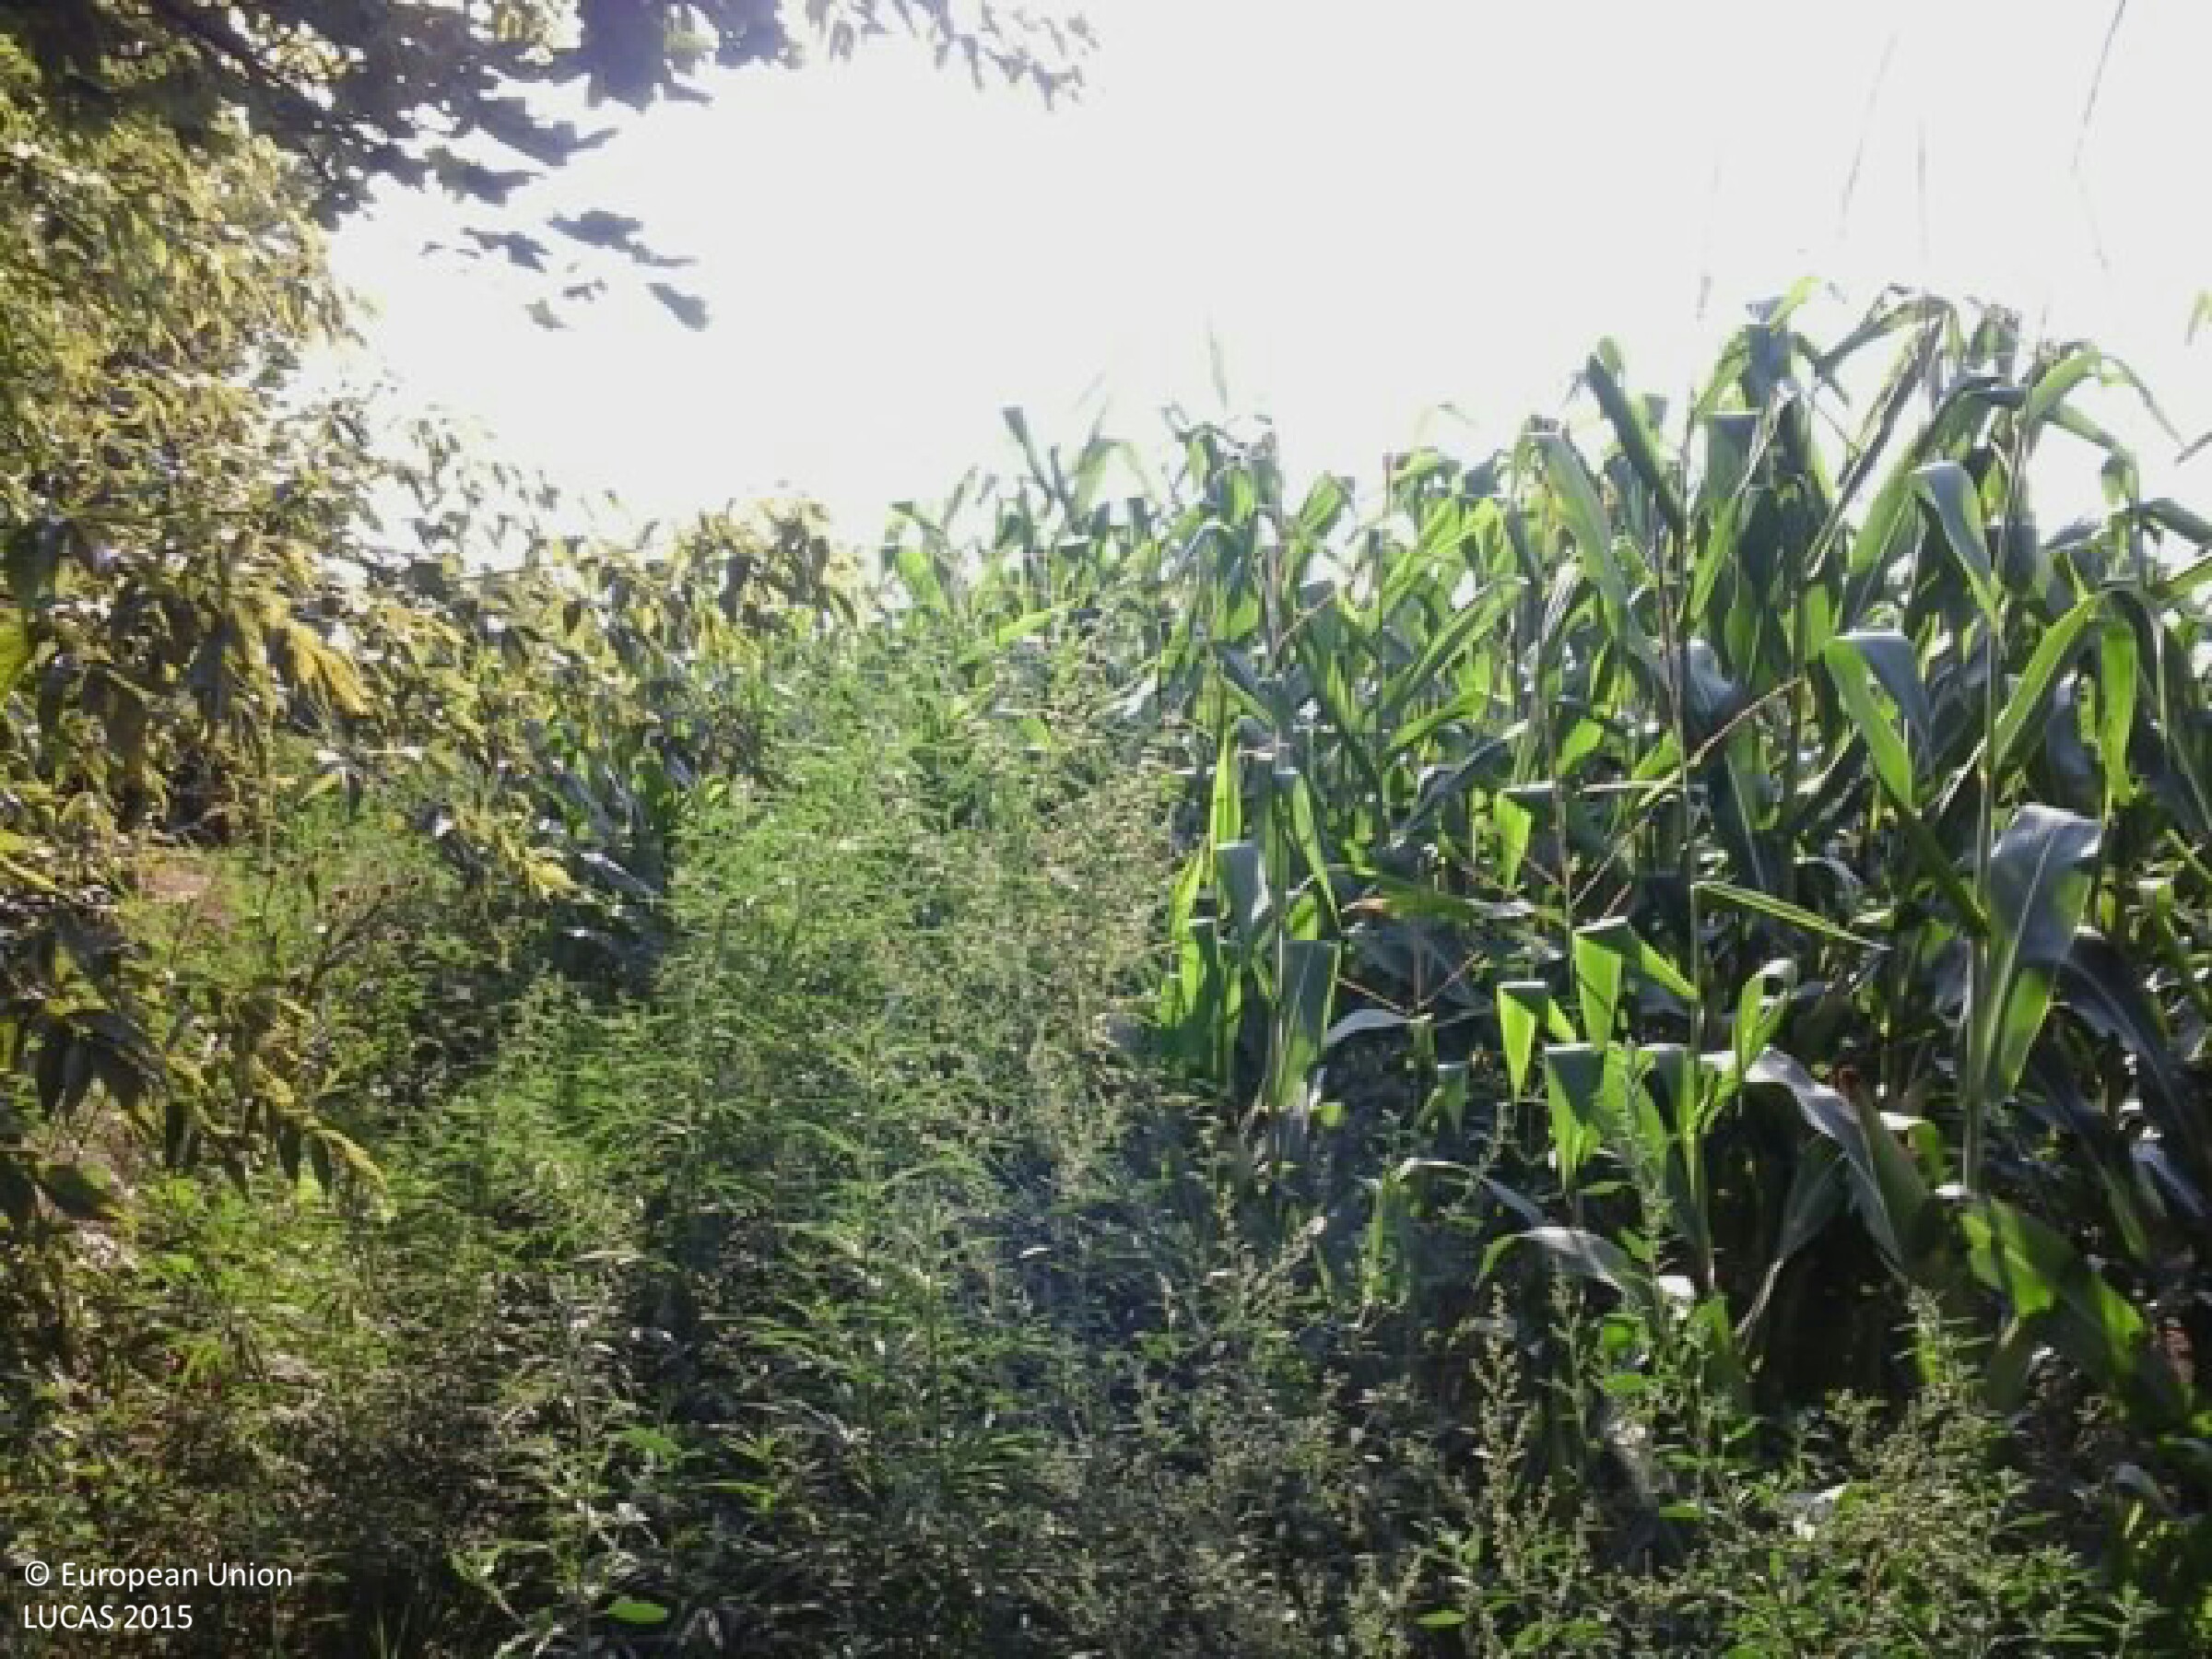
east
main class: Cropland
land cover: Maize
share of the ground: > 75 %
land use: Agriculture (excluding fallow land and kitchen gardens)
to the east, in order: Maize
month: August
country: HU
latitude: 46.4918
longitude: 17.9151
